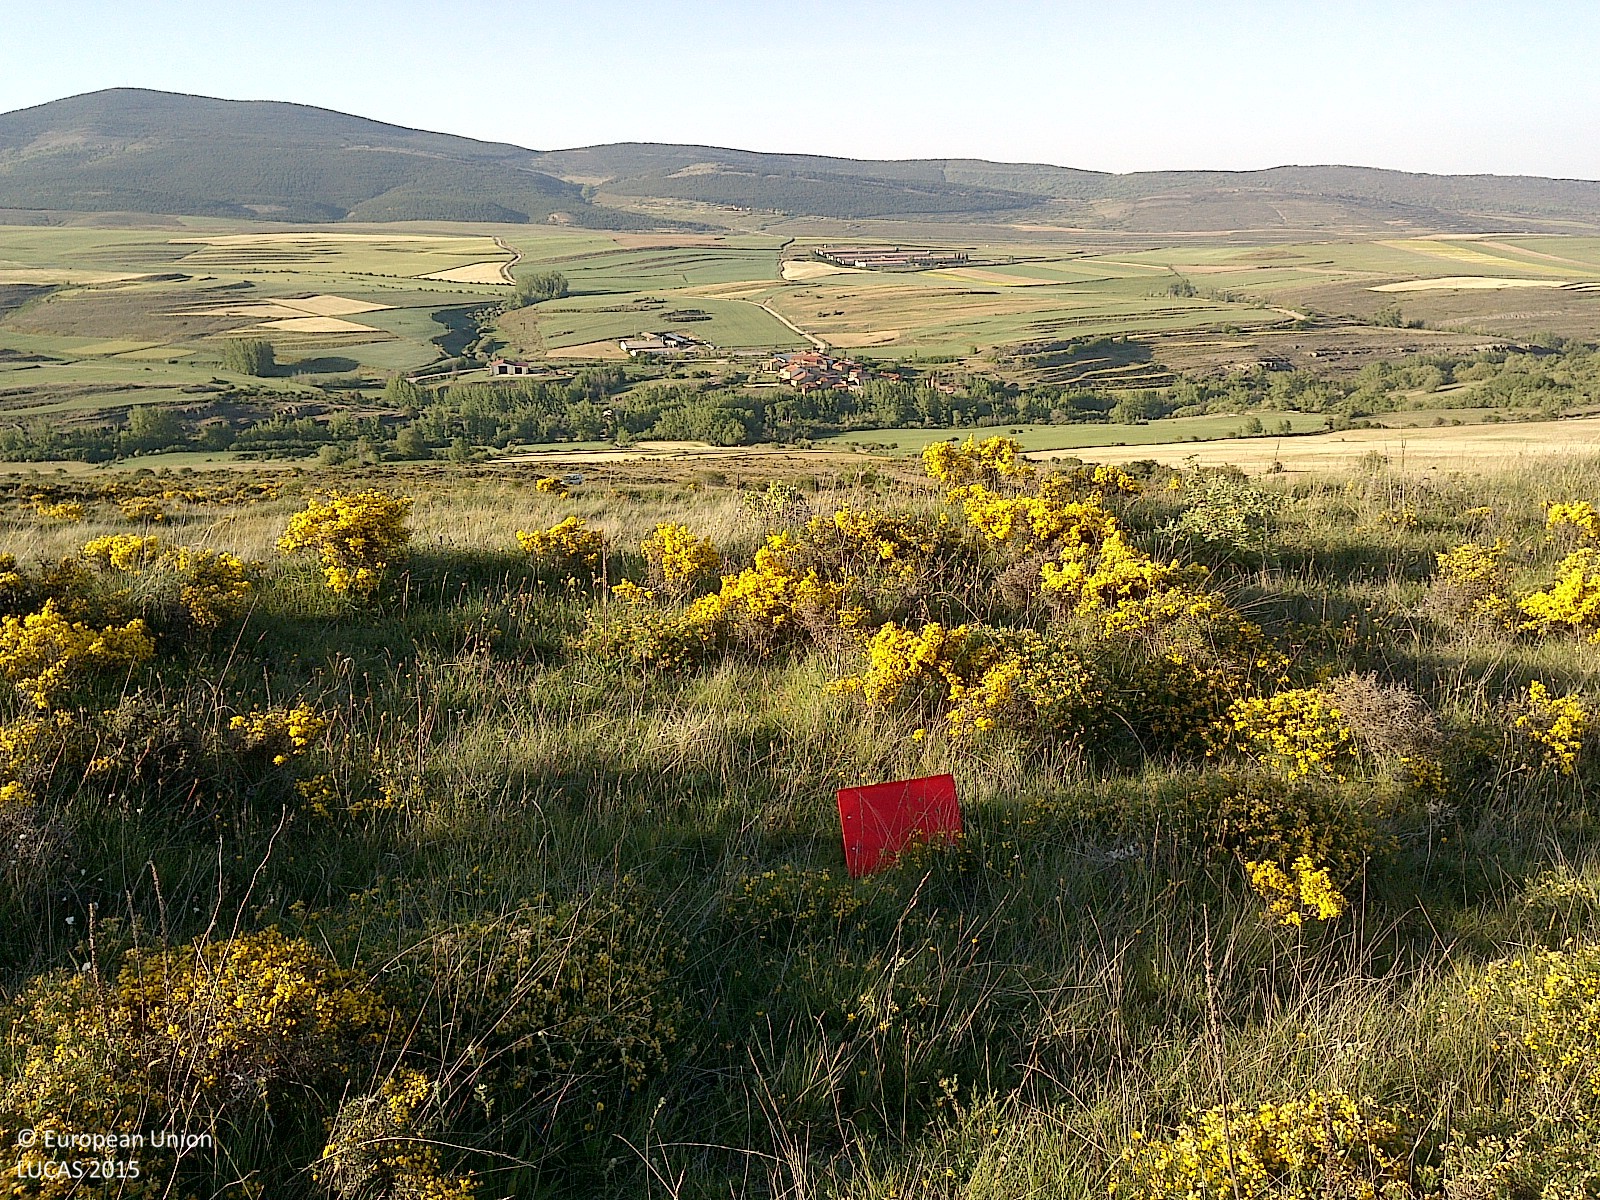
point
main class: Shrubland
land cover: Shrubland without tree cover
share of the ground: 50 - 75 %
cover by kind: shrubs 55 %, herbaceous plants 45 %
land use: Agriculture (excluding fallow land and kitchen gardens)
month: May
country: ES
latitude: 42.0114
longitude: -2.2946
